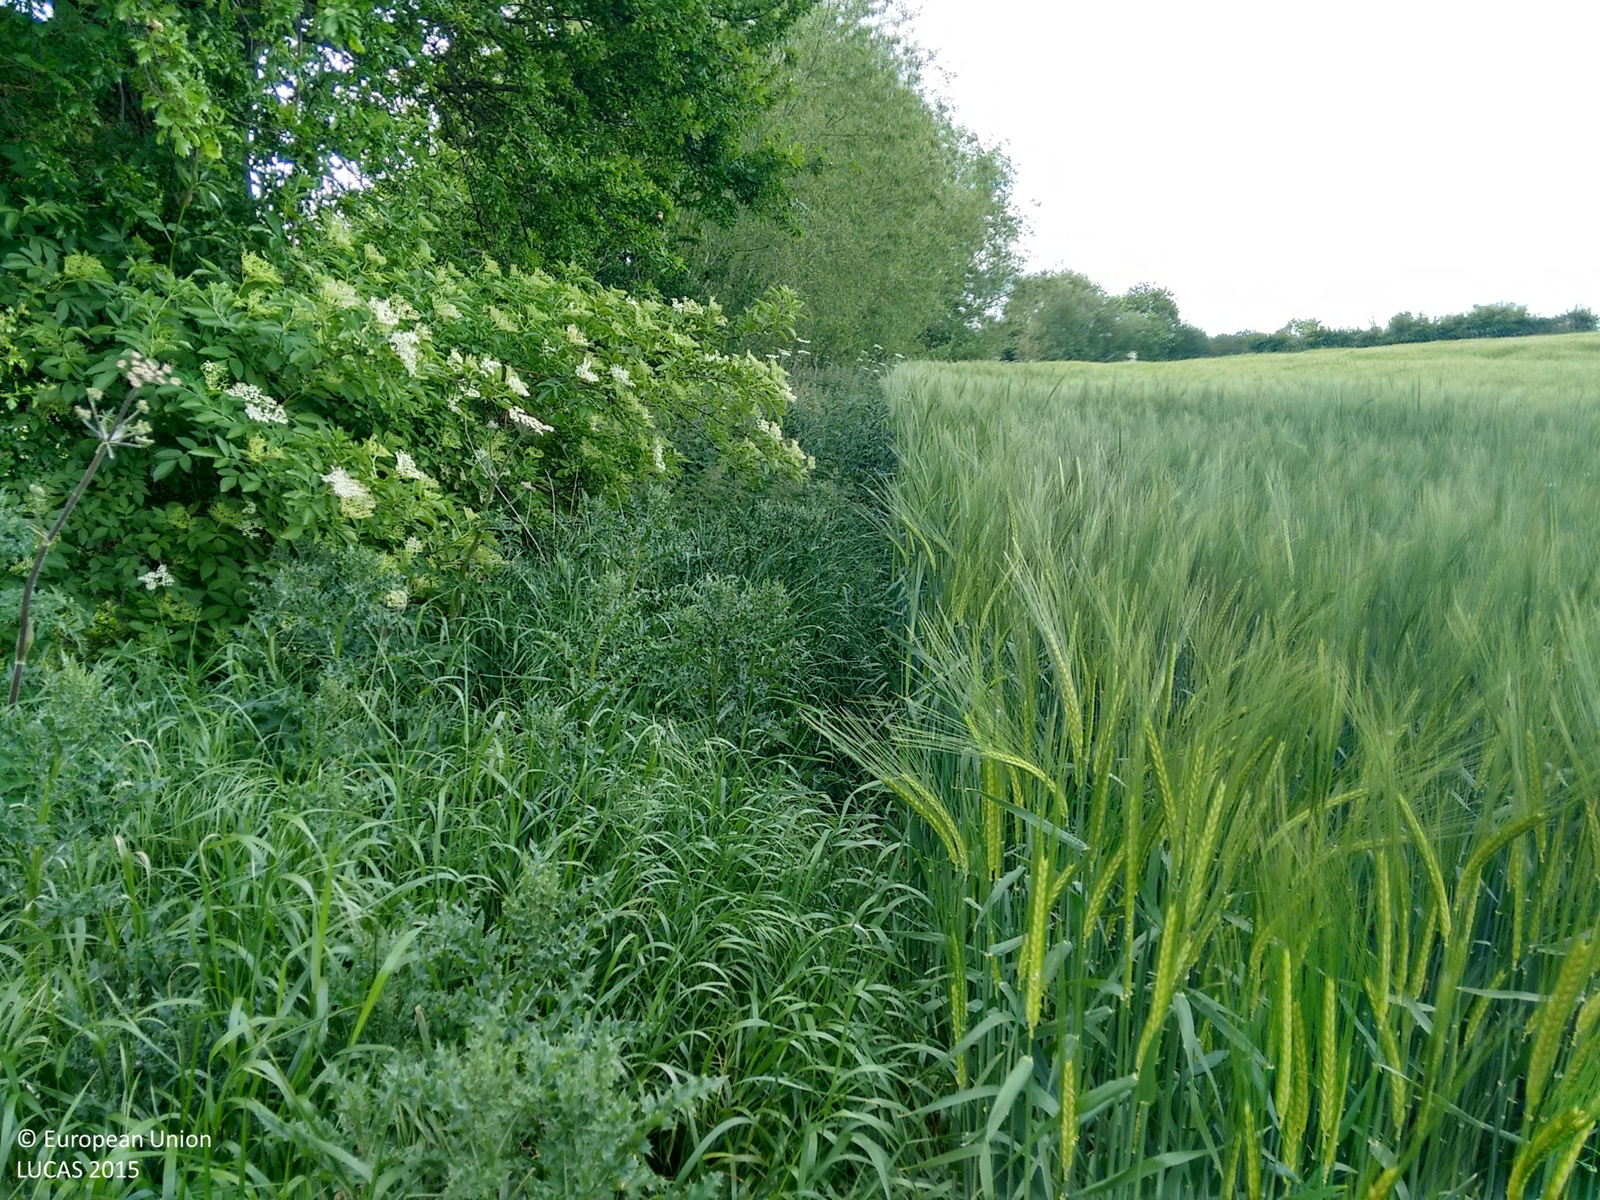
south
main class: Cropland
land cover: Barley
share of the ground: > 75 %
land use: Agriculture (excluding fallow land and kitchen gardens)
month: June
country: GB
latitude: 52.1270
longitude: -1.6662
